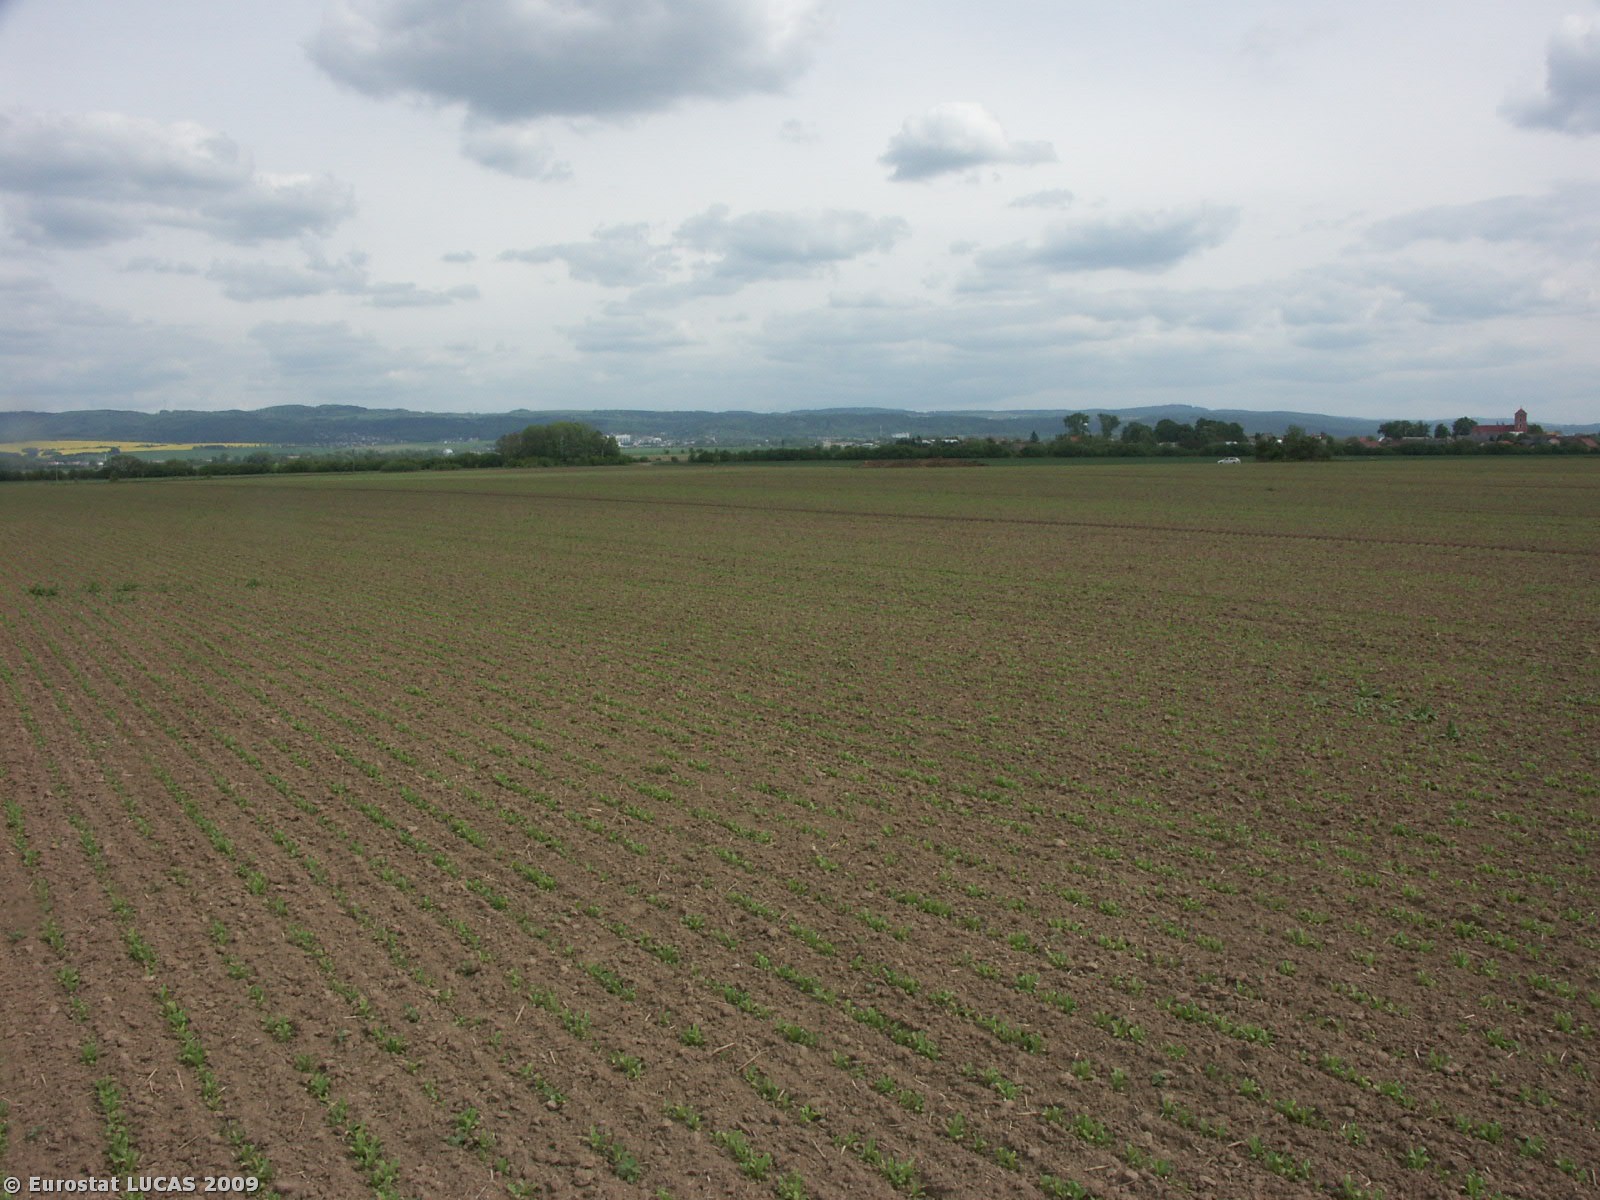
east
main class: Cropland
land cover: Other fibre and oleaginous crops
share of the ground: 10 - 25 %
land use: Agriculture (excluding fallow land and kitchen gardens)
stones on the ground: < 10 %
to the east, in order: Other fibre and oleaginous crops
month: May
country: CZ
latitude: 49.7212
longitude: 17.2096
